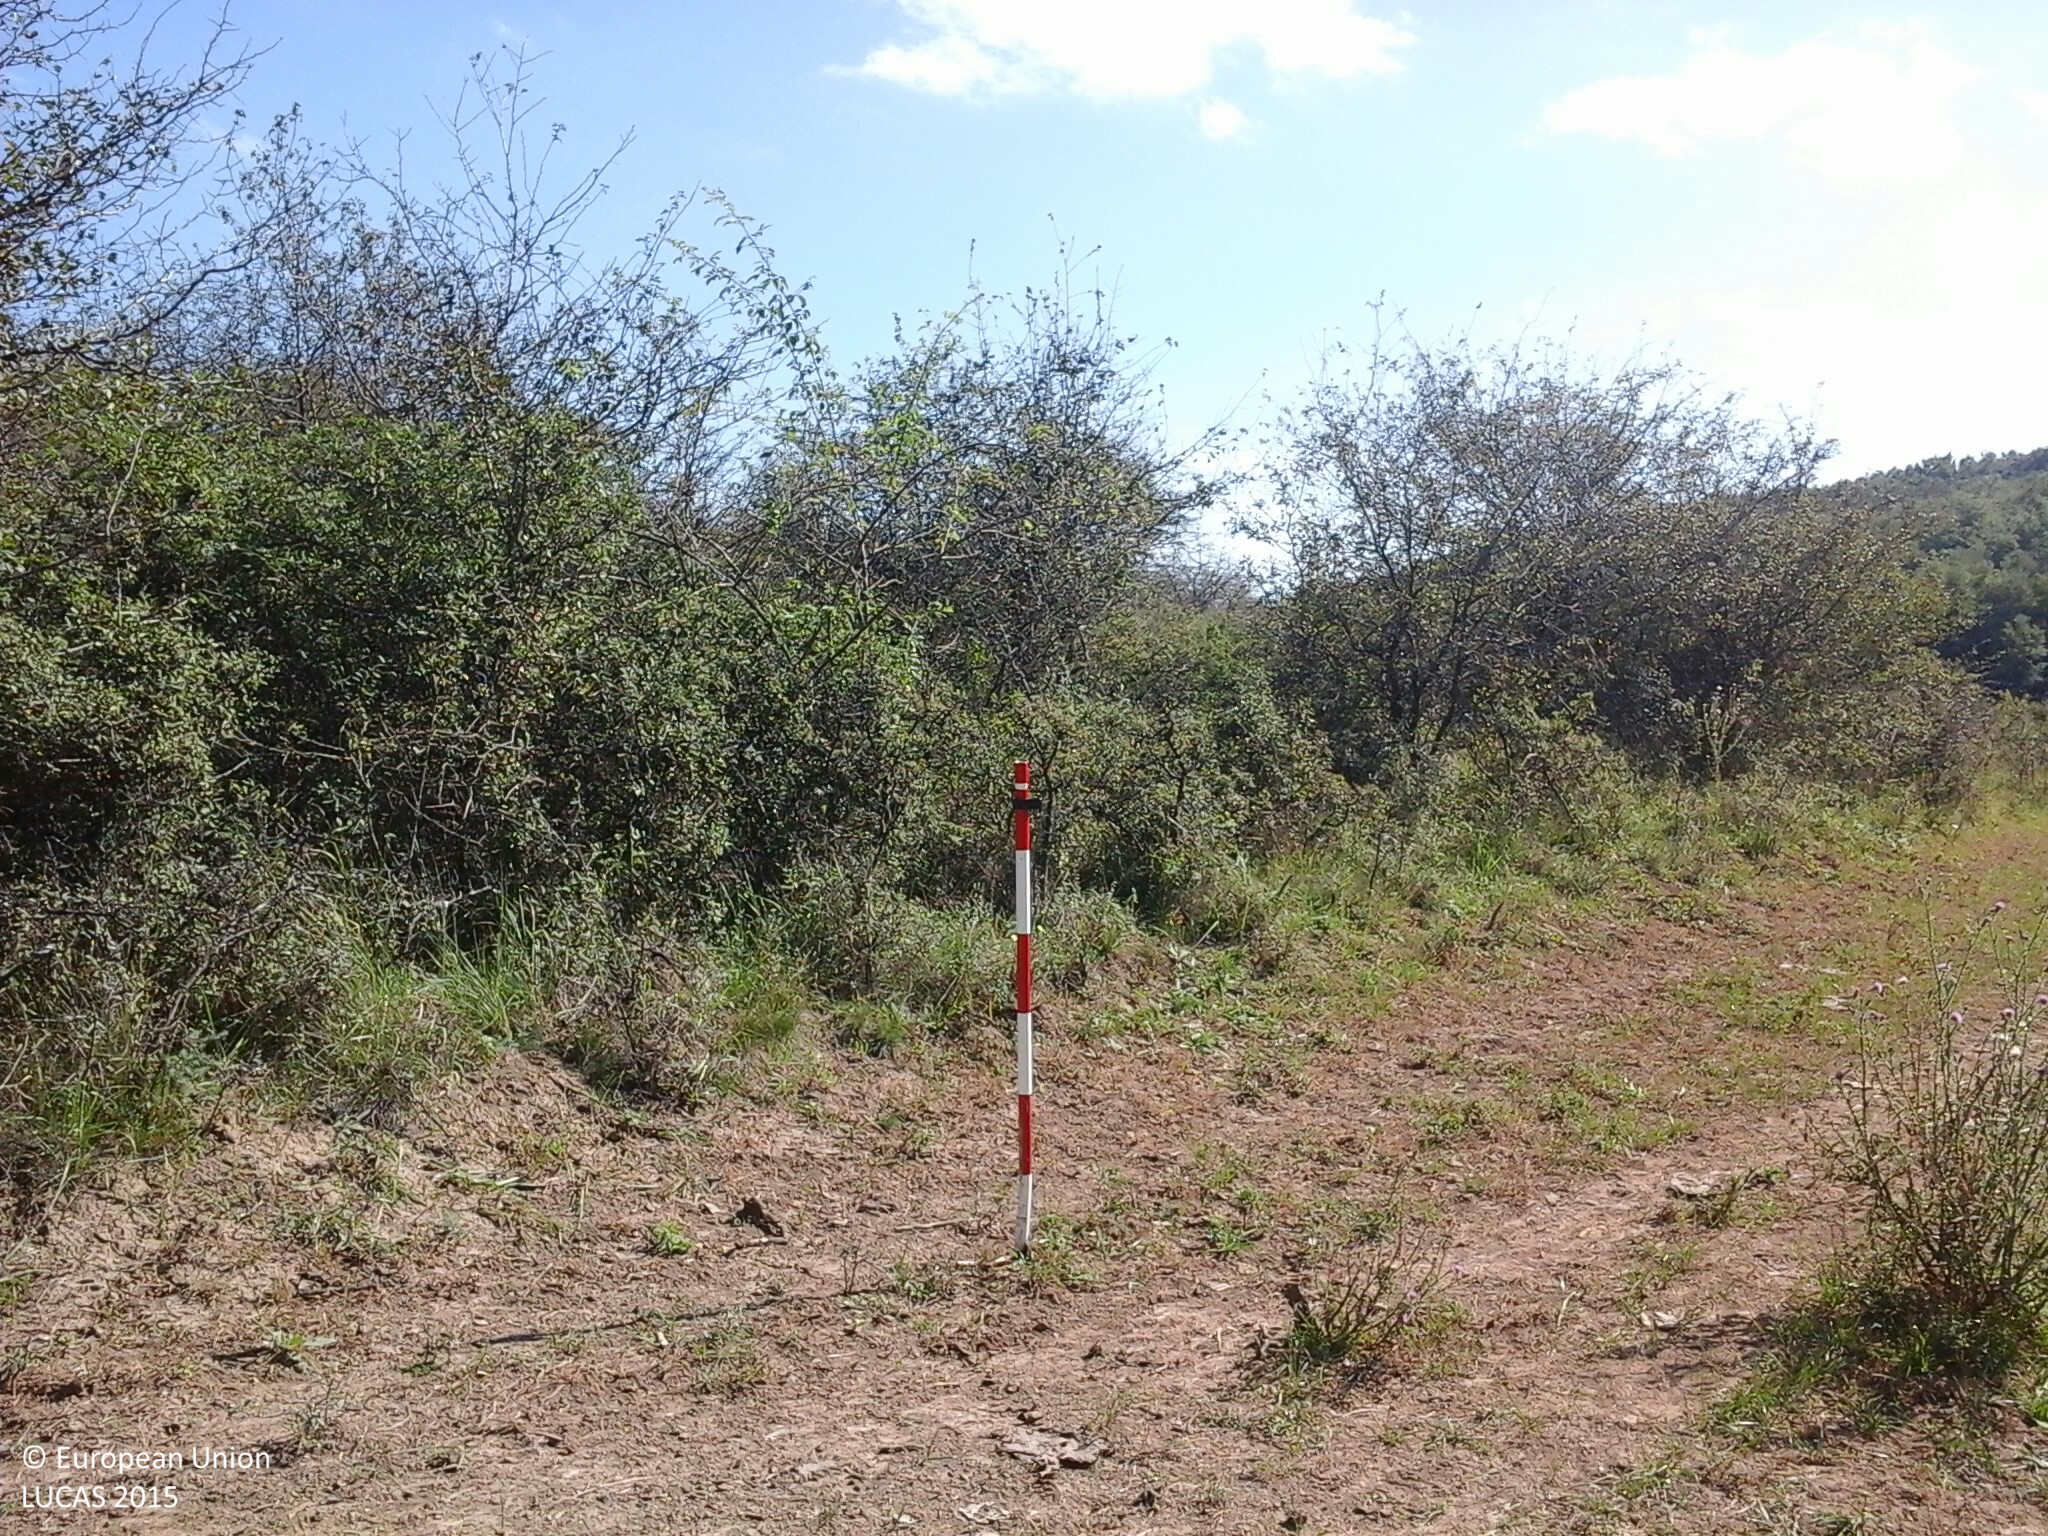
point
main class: Shrubland
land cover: Shrubland with sparse tree cover
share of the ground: > 75 %
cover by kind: shrubs 90 %, broadleaved forest trees 5 %, herbaceous plants 5 %
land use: Agriculture (excluding fallow land and kitchen gardens)
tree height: < 5 m
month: September
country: HU
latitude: 48.0143
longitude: 19.8805
